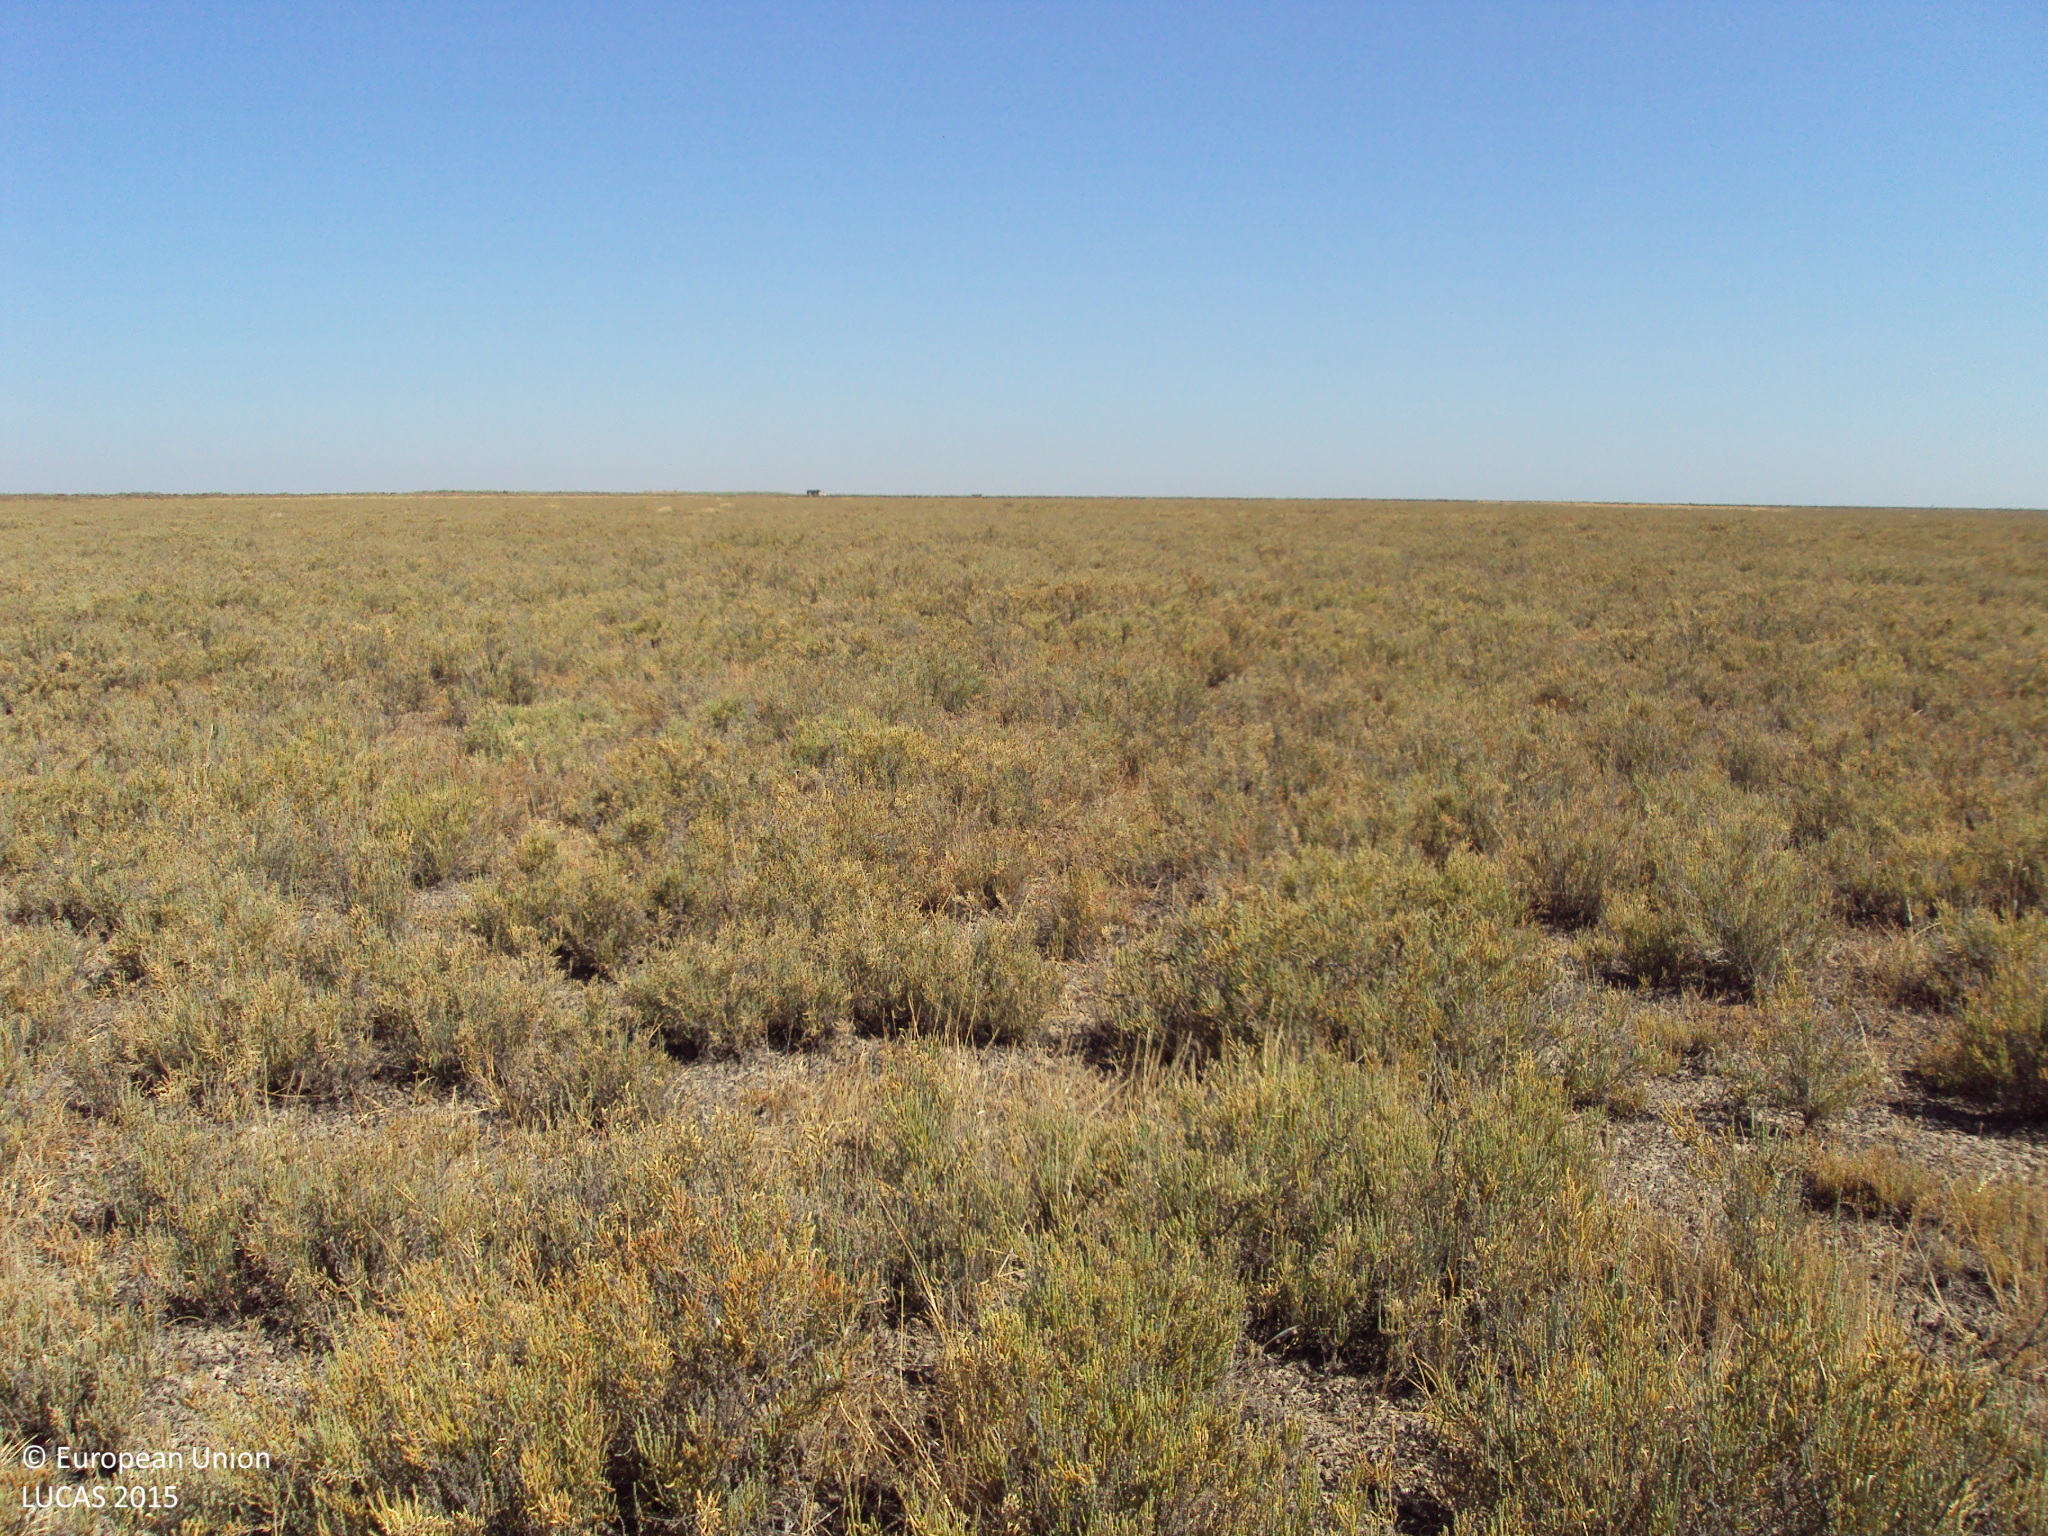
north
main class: Shrubland
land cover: Shrubland without tree cover
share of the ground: > 75 %
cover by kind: shrubs 70 %, consolidated bare surface 20 %, herbaceous plants 10 %
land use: Agriculture (excluding fallow land and kitchen gardens)
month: July
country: ES
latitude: 36.9278
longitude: -6.2638
